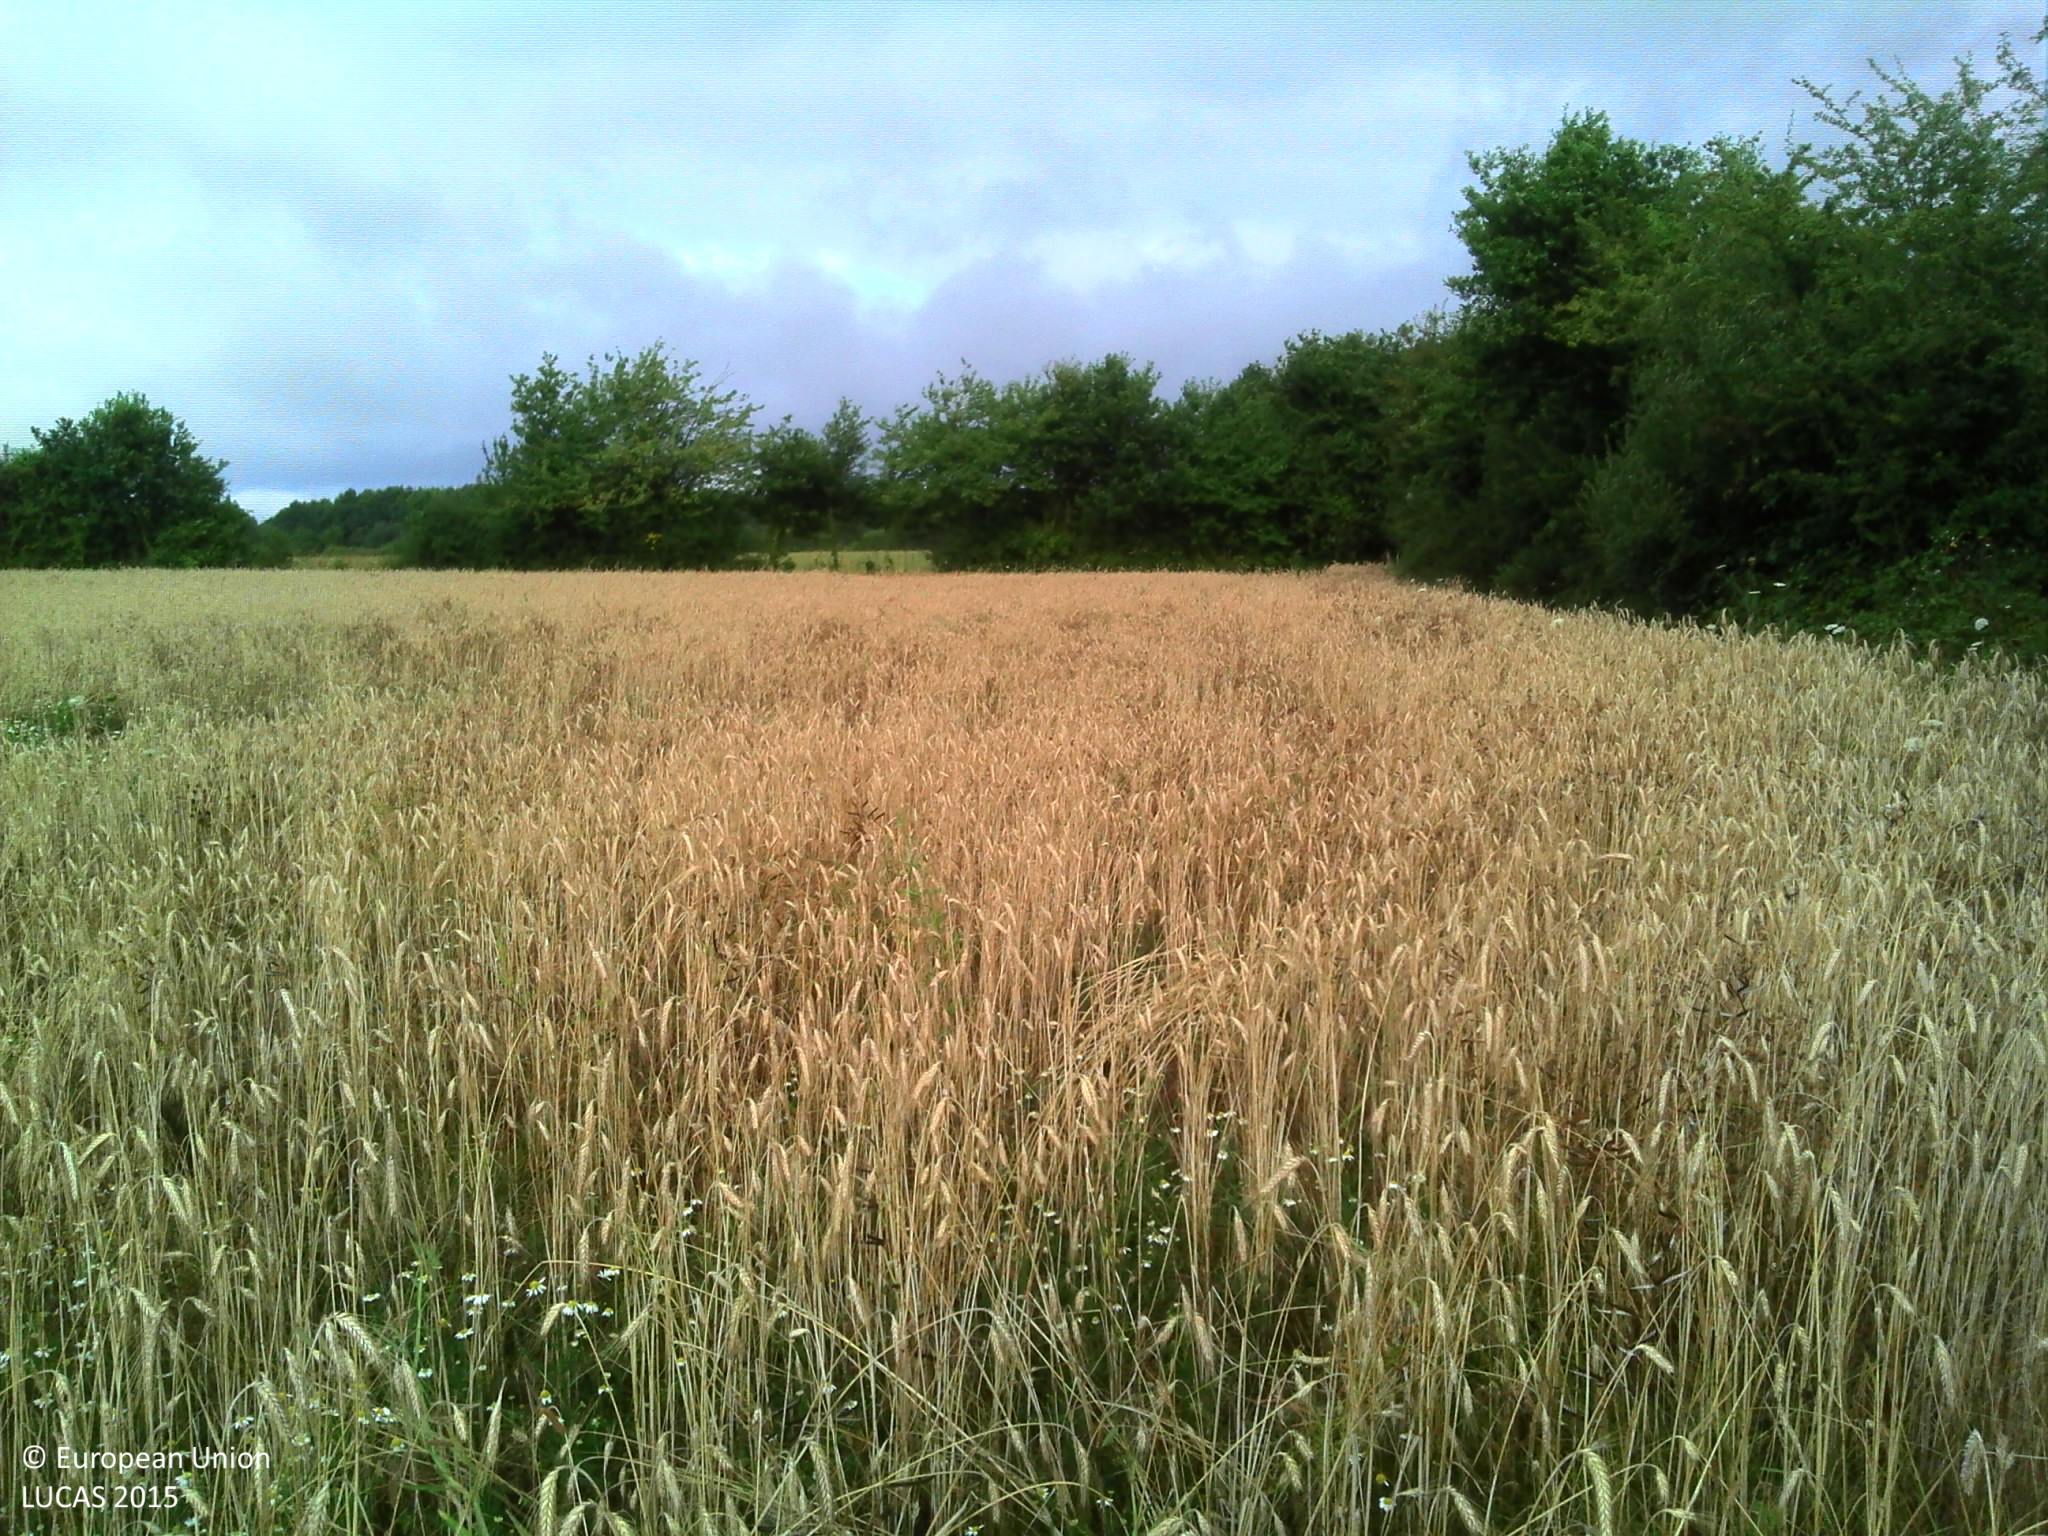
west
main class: Cropland
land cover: Common wheat
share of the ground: > 75 %
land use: Agriculture (excluding fallow land and kitchen gardens)
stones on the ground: 10 - 25 %
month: July
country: FR
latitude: 47.5032
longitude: -1.9037
